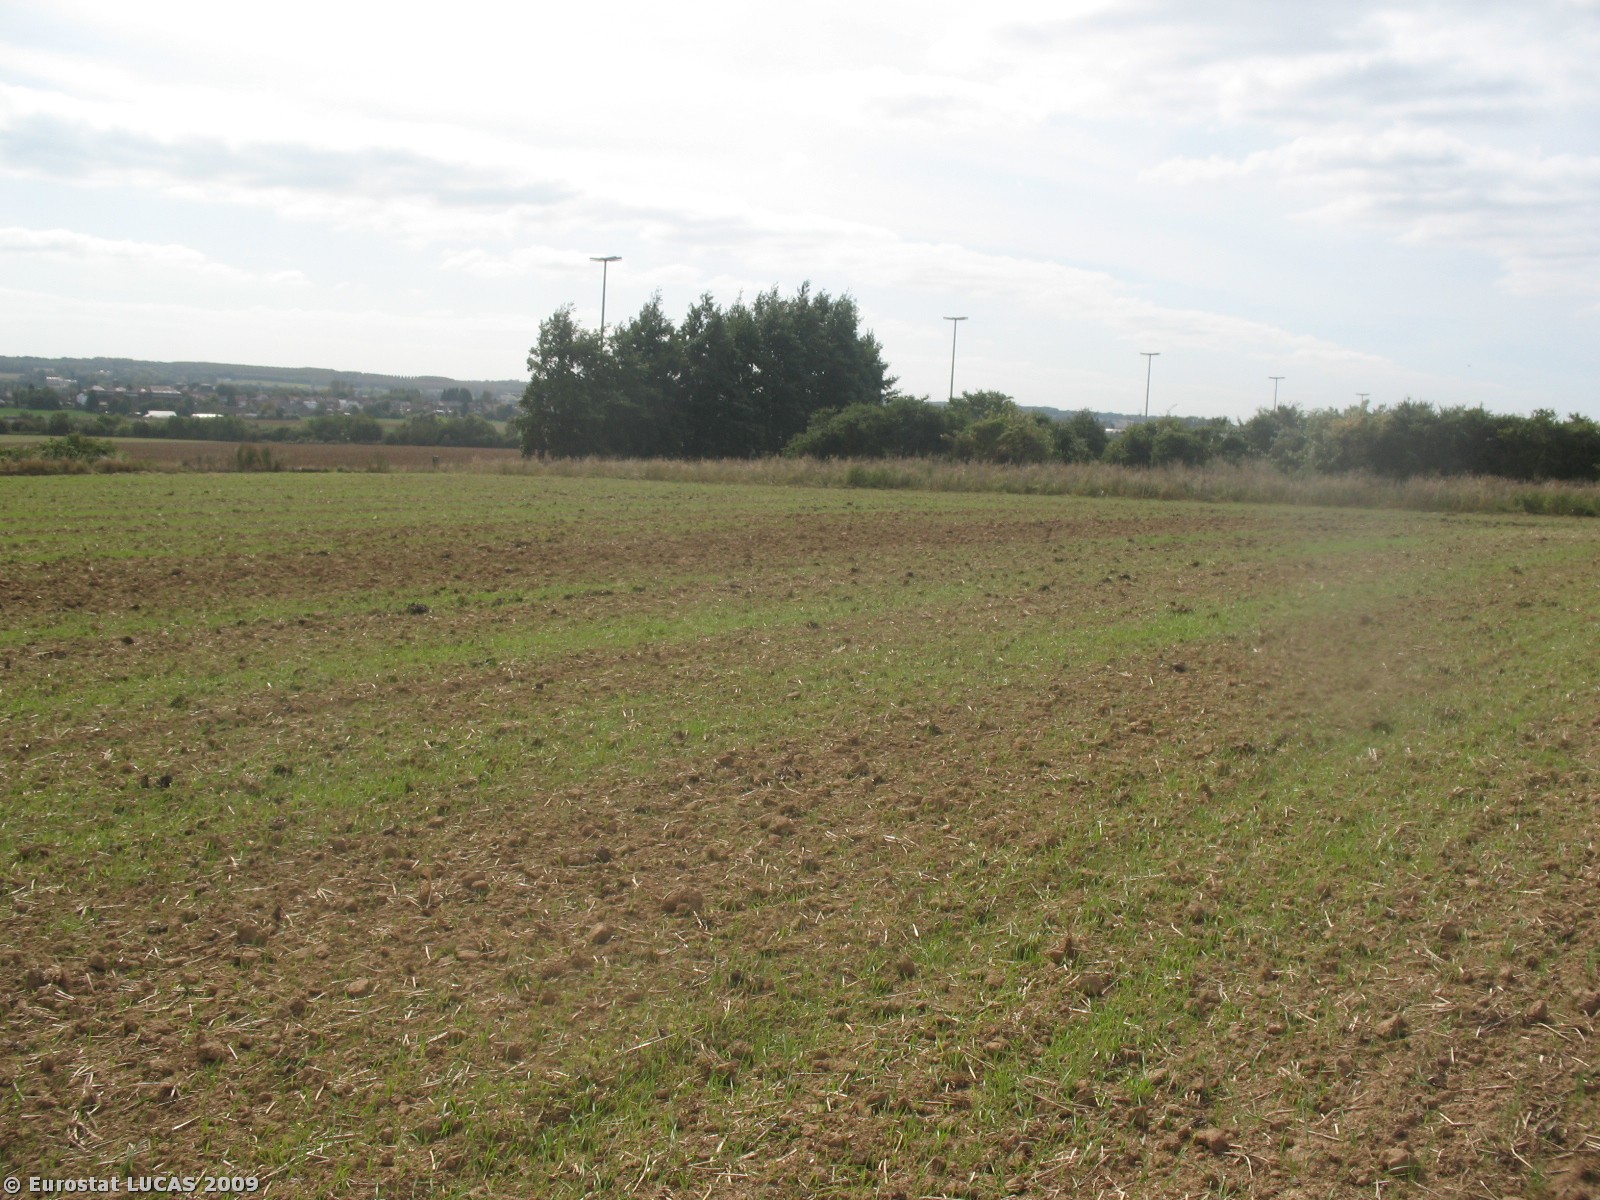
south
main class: Cropland
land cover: Temporary grasslands
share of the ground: < 10 %
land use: Agriculture (excluding fallow land and kitchen gardens)
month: September
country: BE
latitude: 50.3205
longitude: 4.1098
